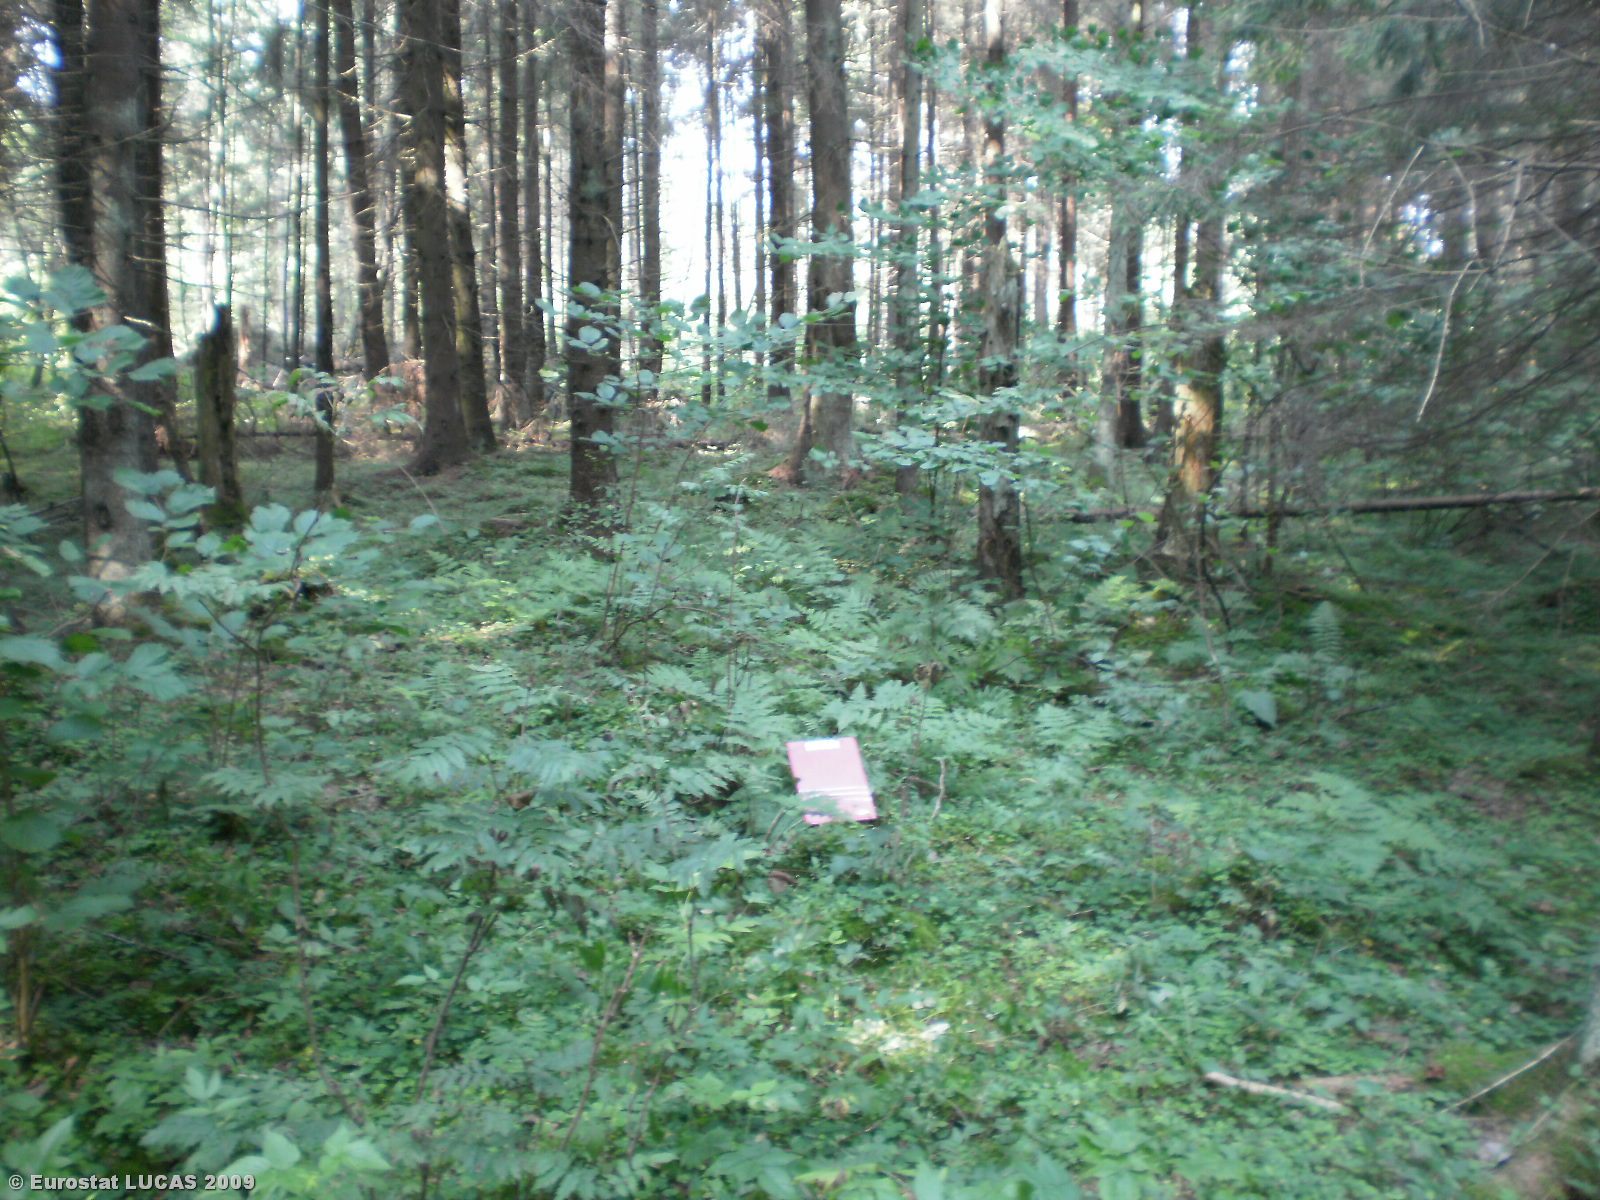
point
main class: Woodland
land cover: Coniferous woodland
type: hemiboreal forest and nemoral coniferous forest and mixed broadleaved-coniferous forest
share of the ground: > 75 %
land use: Forestry
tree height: > 5 m
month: July
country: LT
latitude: 55.8816
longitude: 25.7804
